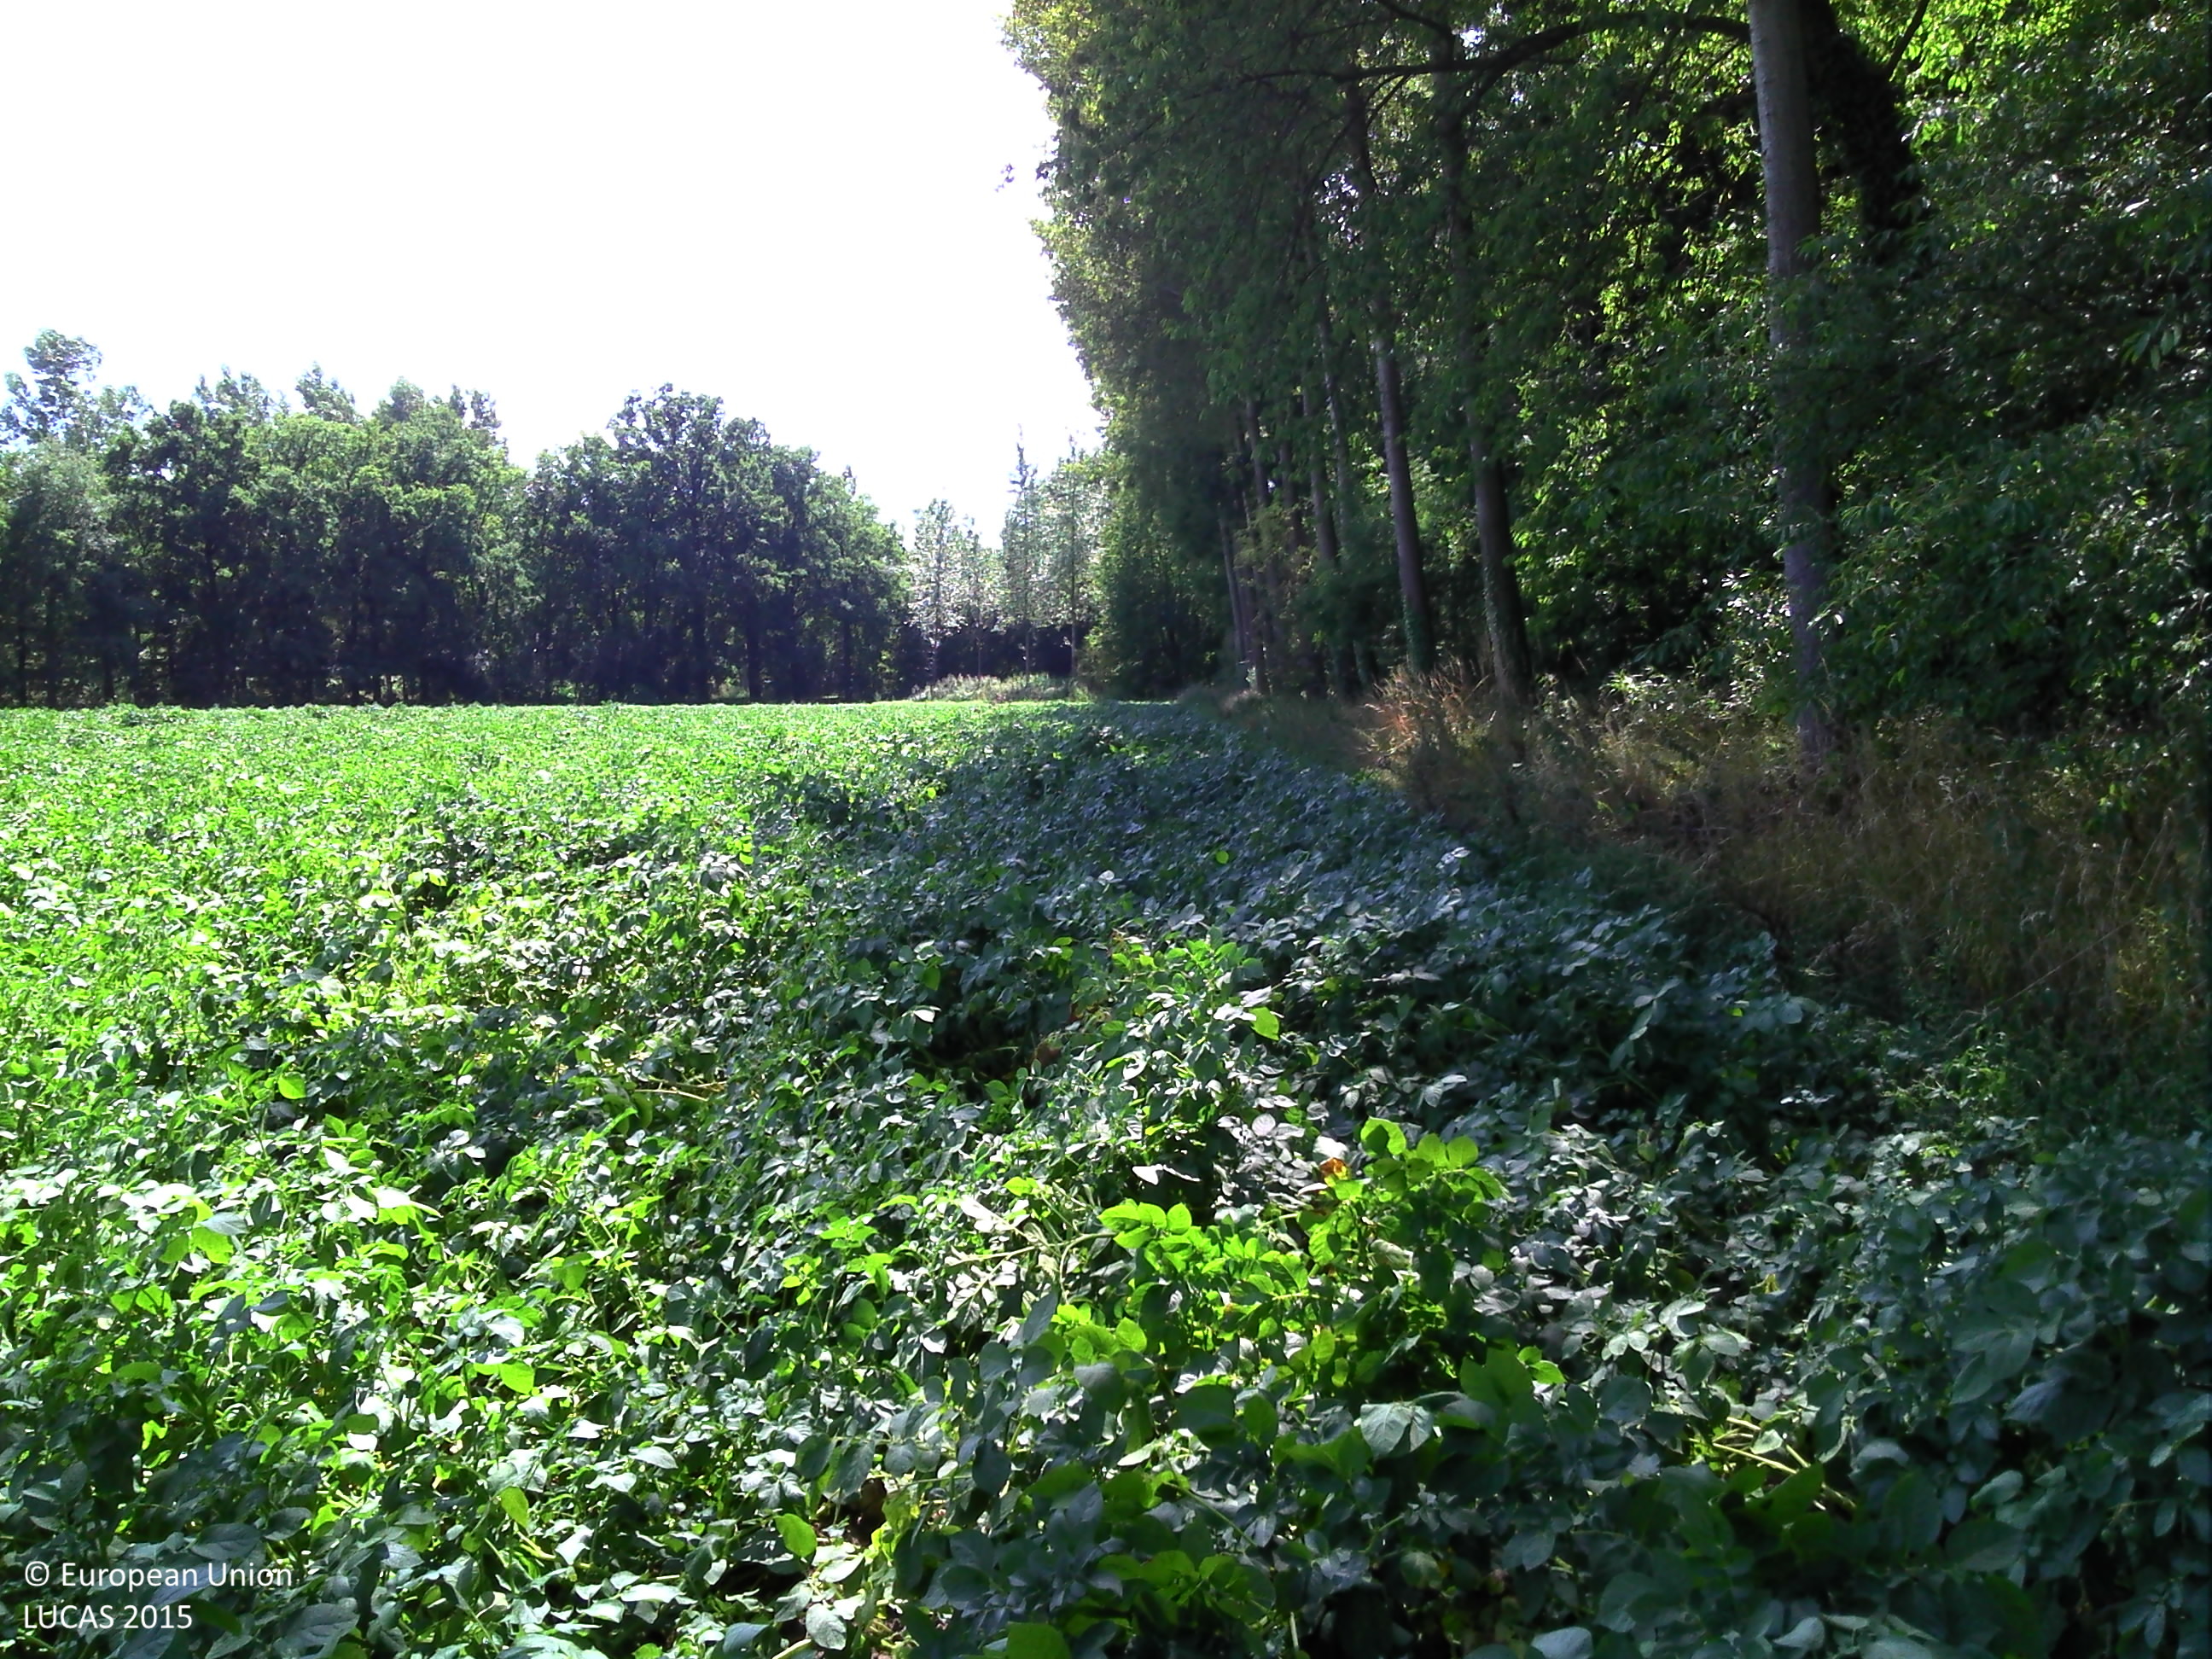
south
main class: Cropland
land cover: Potatoes
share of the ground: > 75 %
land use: Agriculture (excluding fallow land and kitchen gardens)
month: August
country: BE
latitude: 51.2317
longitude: 5.5443
